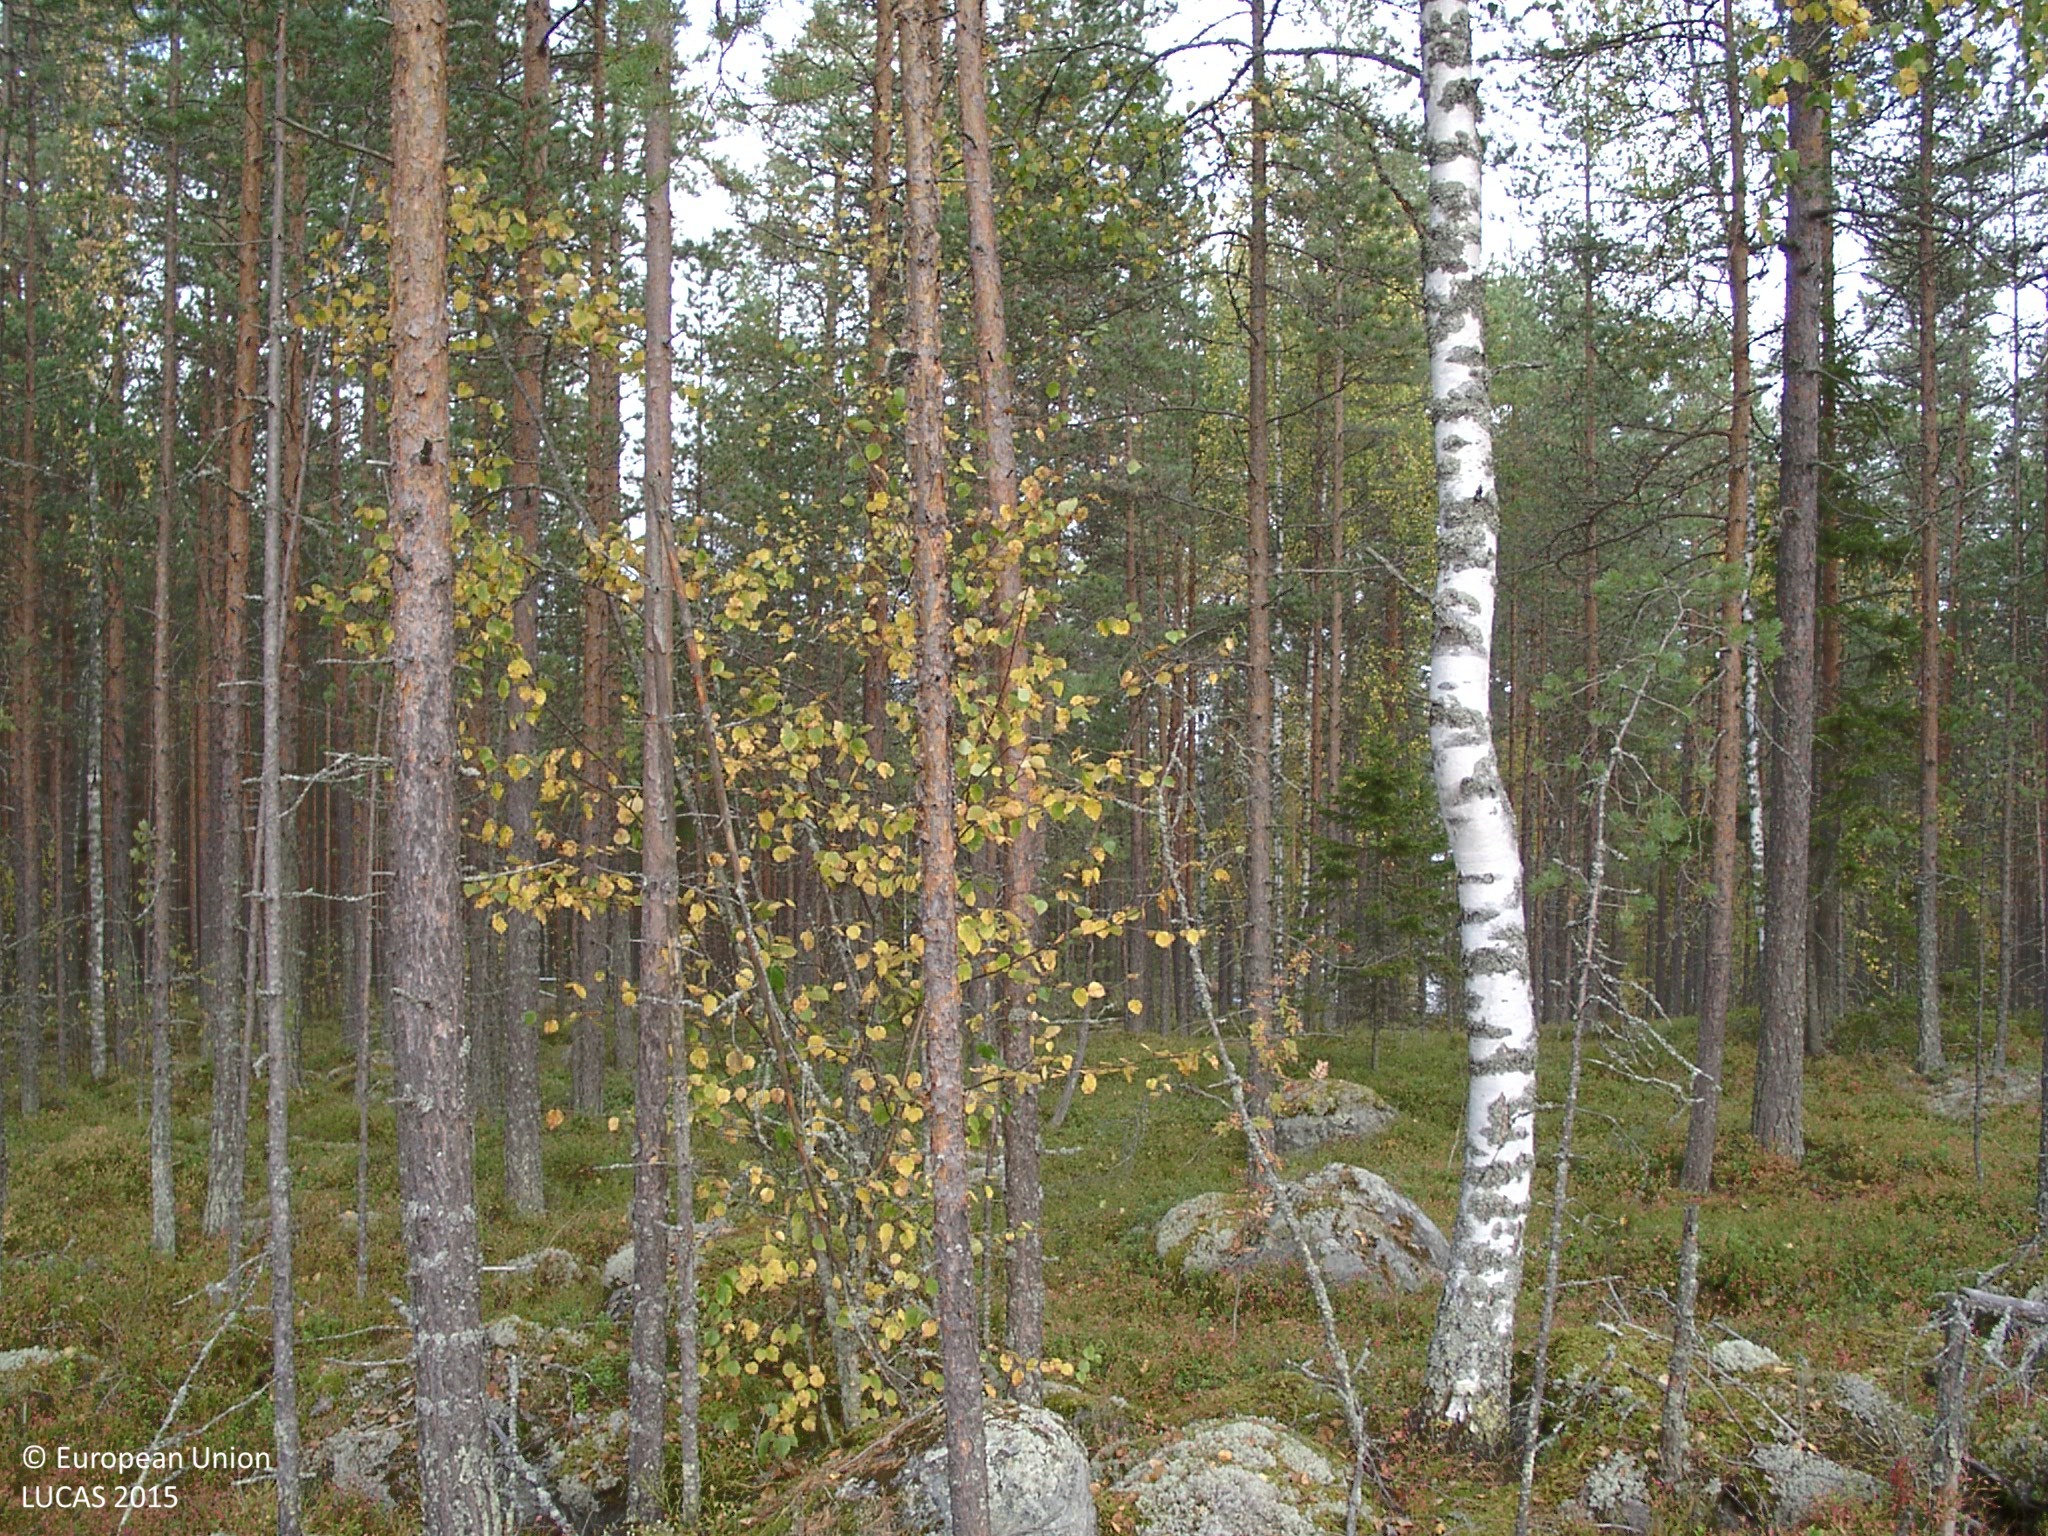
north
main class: Shrubland
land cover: Shrubland without tree cover
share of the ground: > 75 %
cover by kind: shrubs 80 %, lichens and mosses 20 %
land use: Electricity, gas and thermal power distribution
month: September
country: FI
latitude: 62.6837
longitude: 25.3618
